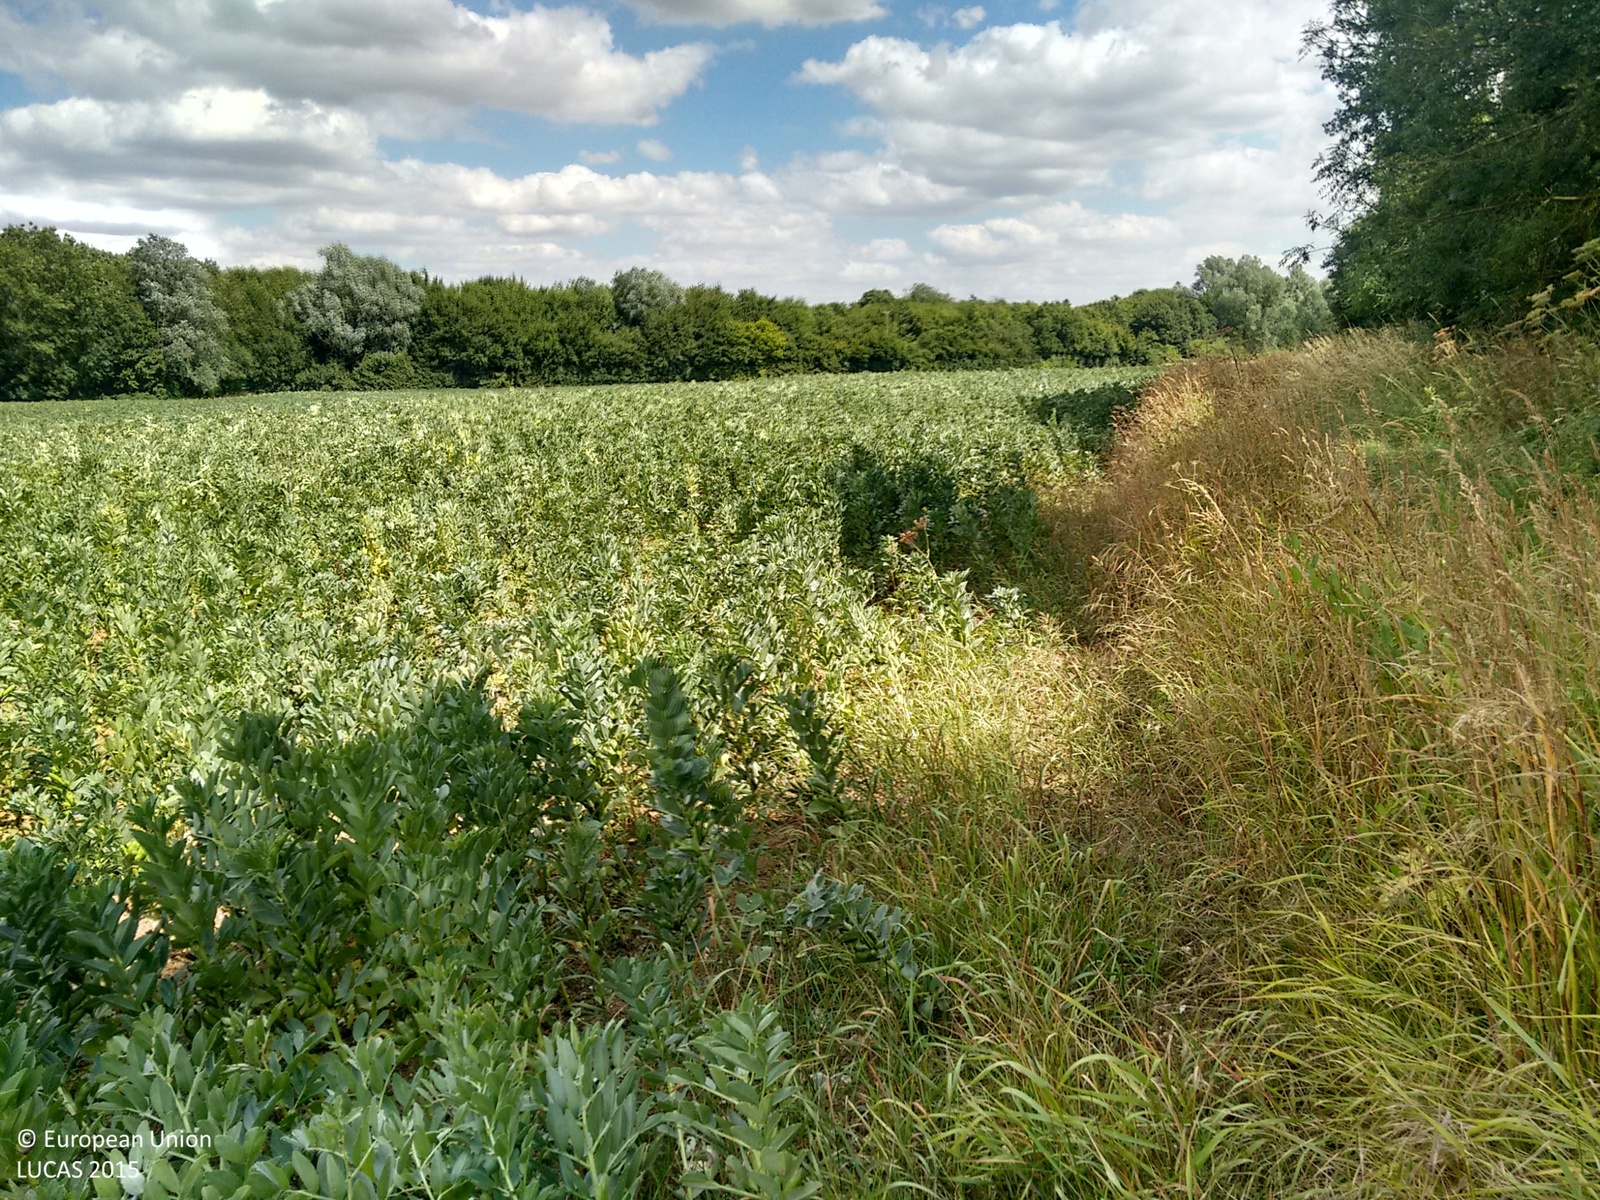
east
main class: Cropland
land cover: Dry pulses
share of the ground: > 75 %
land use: Agriculture (excluding fallow land and kitchen gardens)
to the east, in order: Dry pulses; Grass margins; Ditches and canals; Broadleaved woodland; Electric lines; Broadleaved woodland; Tracks; Broadleaved woodland
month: July
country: GB
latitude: 51.8076
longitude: 0.4135
